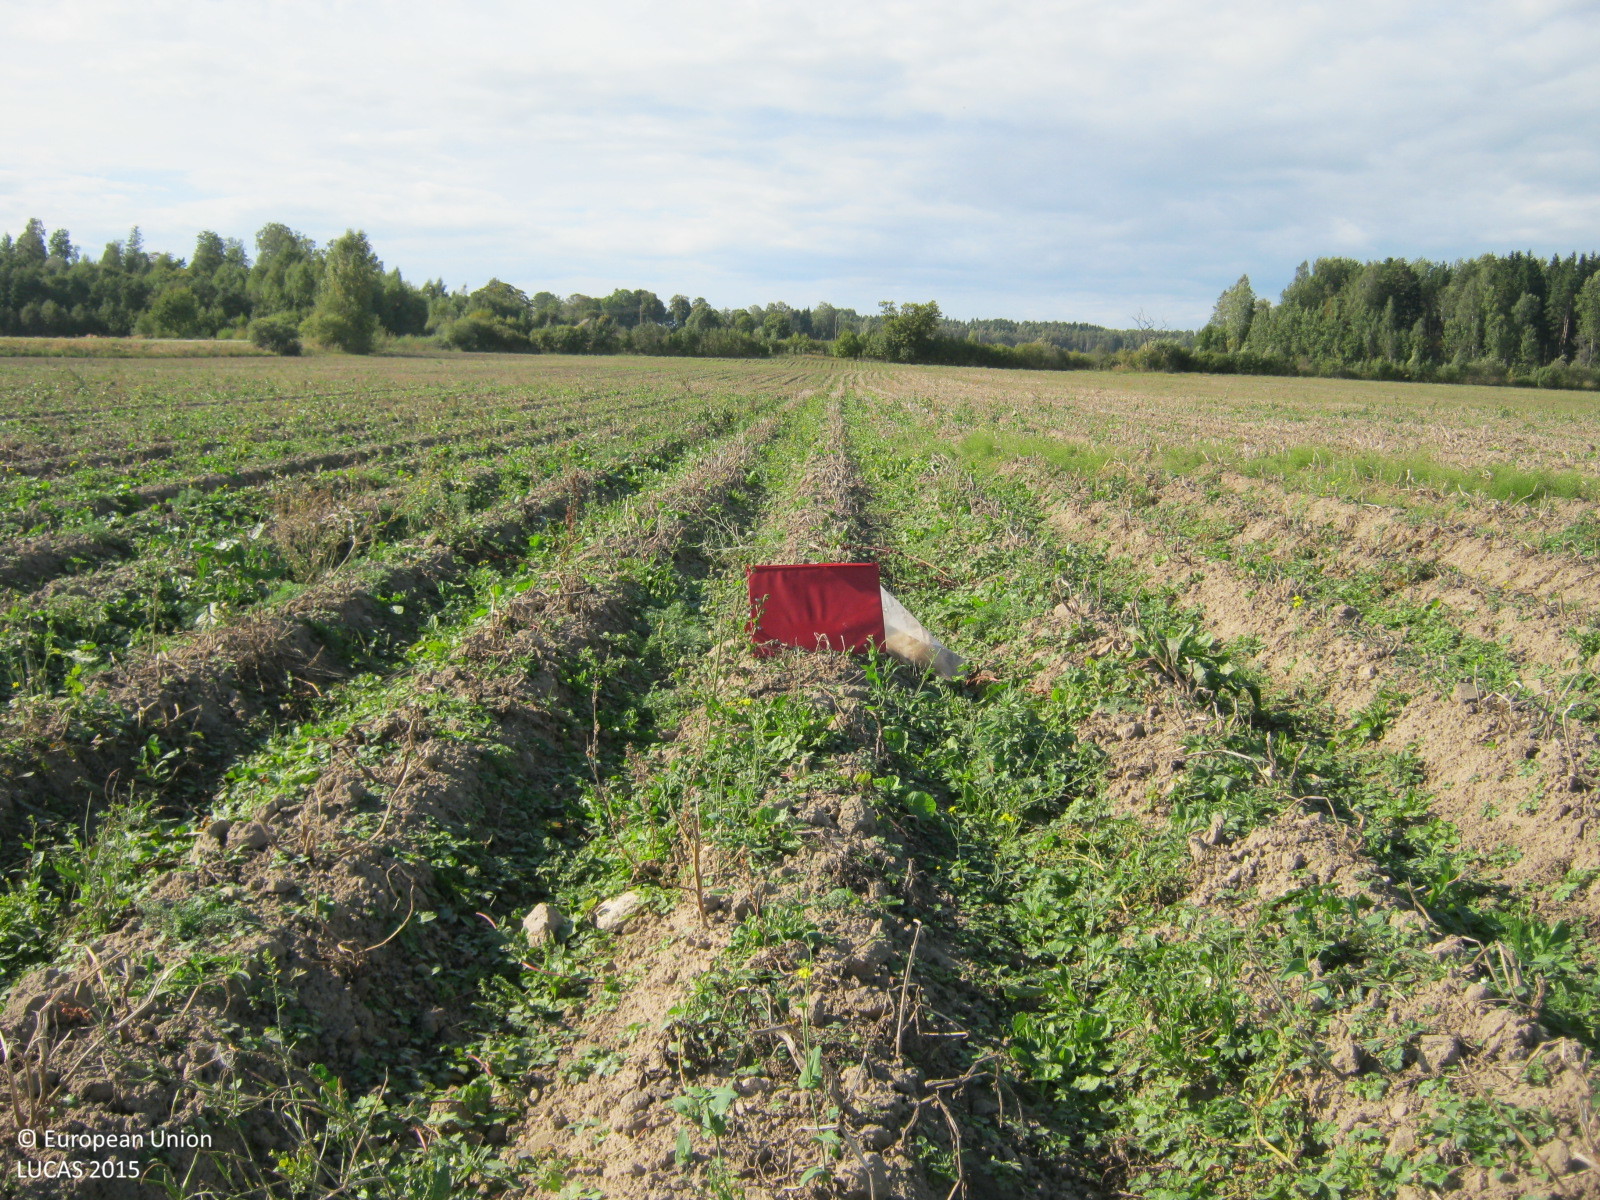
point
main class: Cropland
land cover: Potatoes
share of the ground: < 10 %
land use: Agriculture (excluding fallow land and kitchen gardens)
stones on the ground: < 10 %
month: September
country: LV
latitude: 57.3390
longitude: 24.6322
